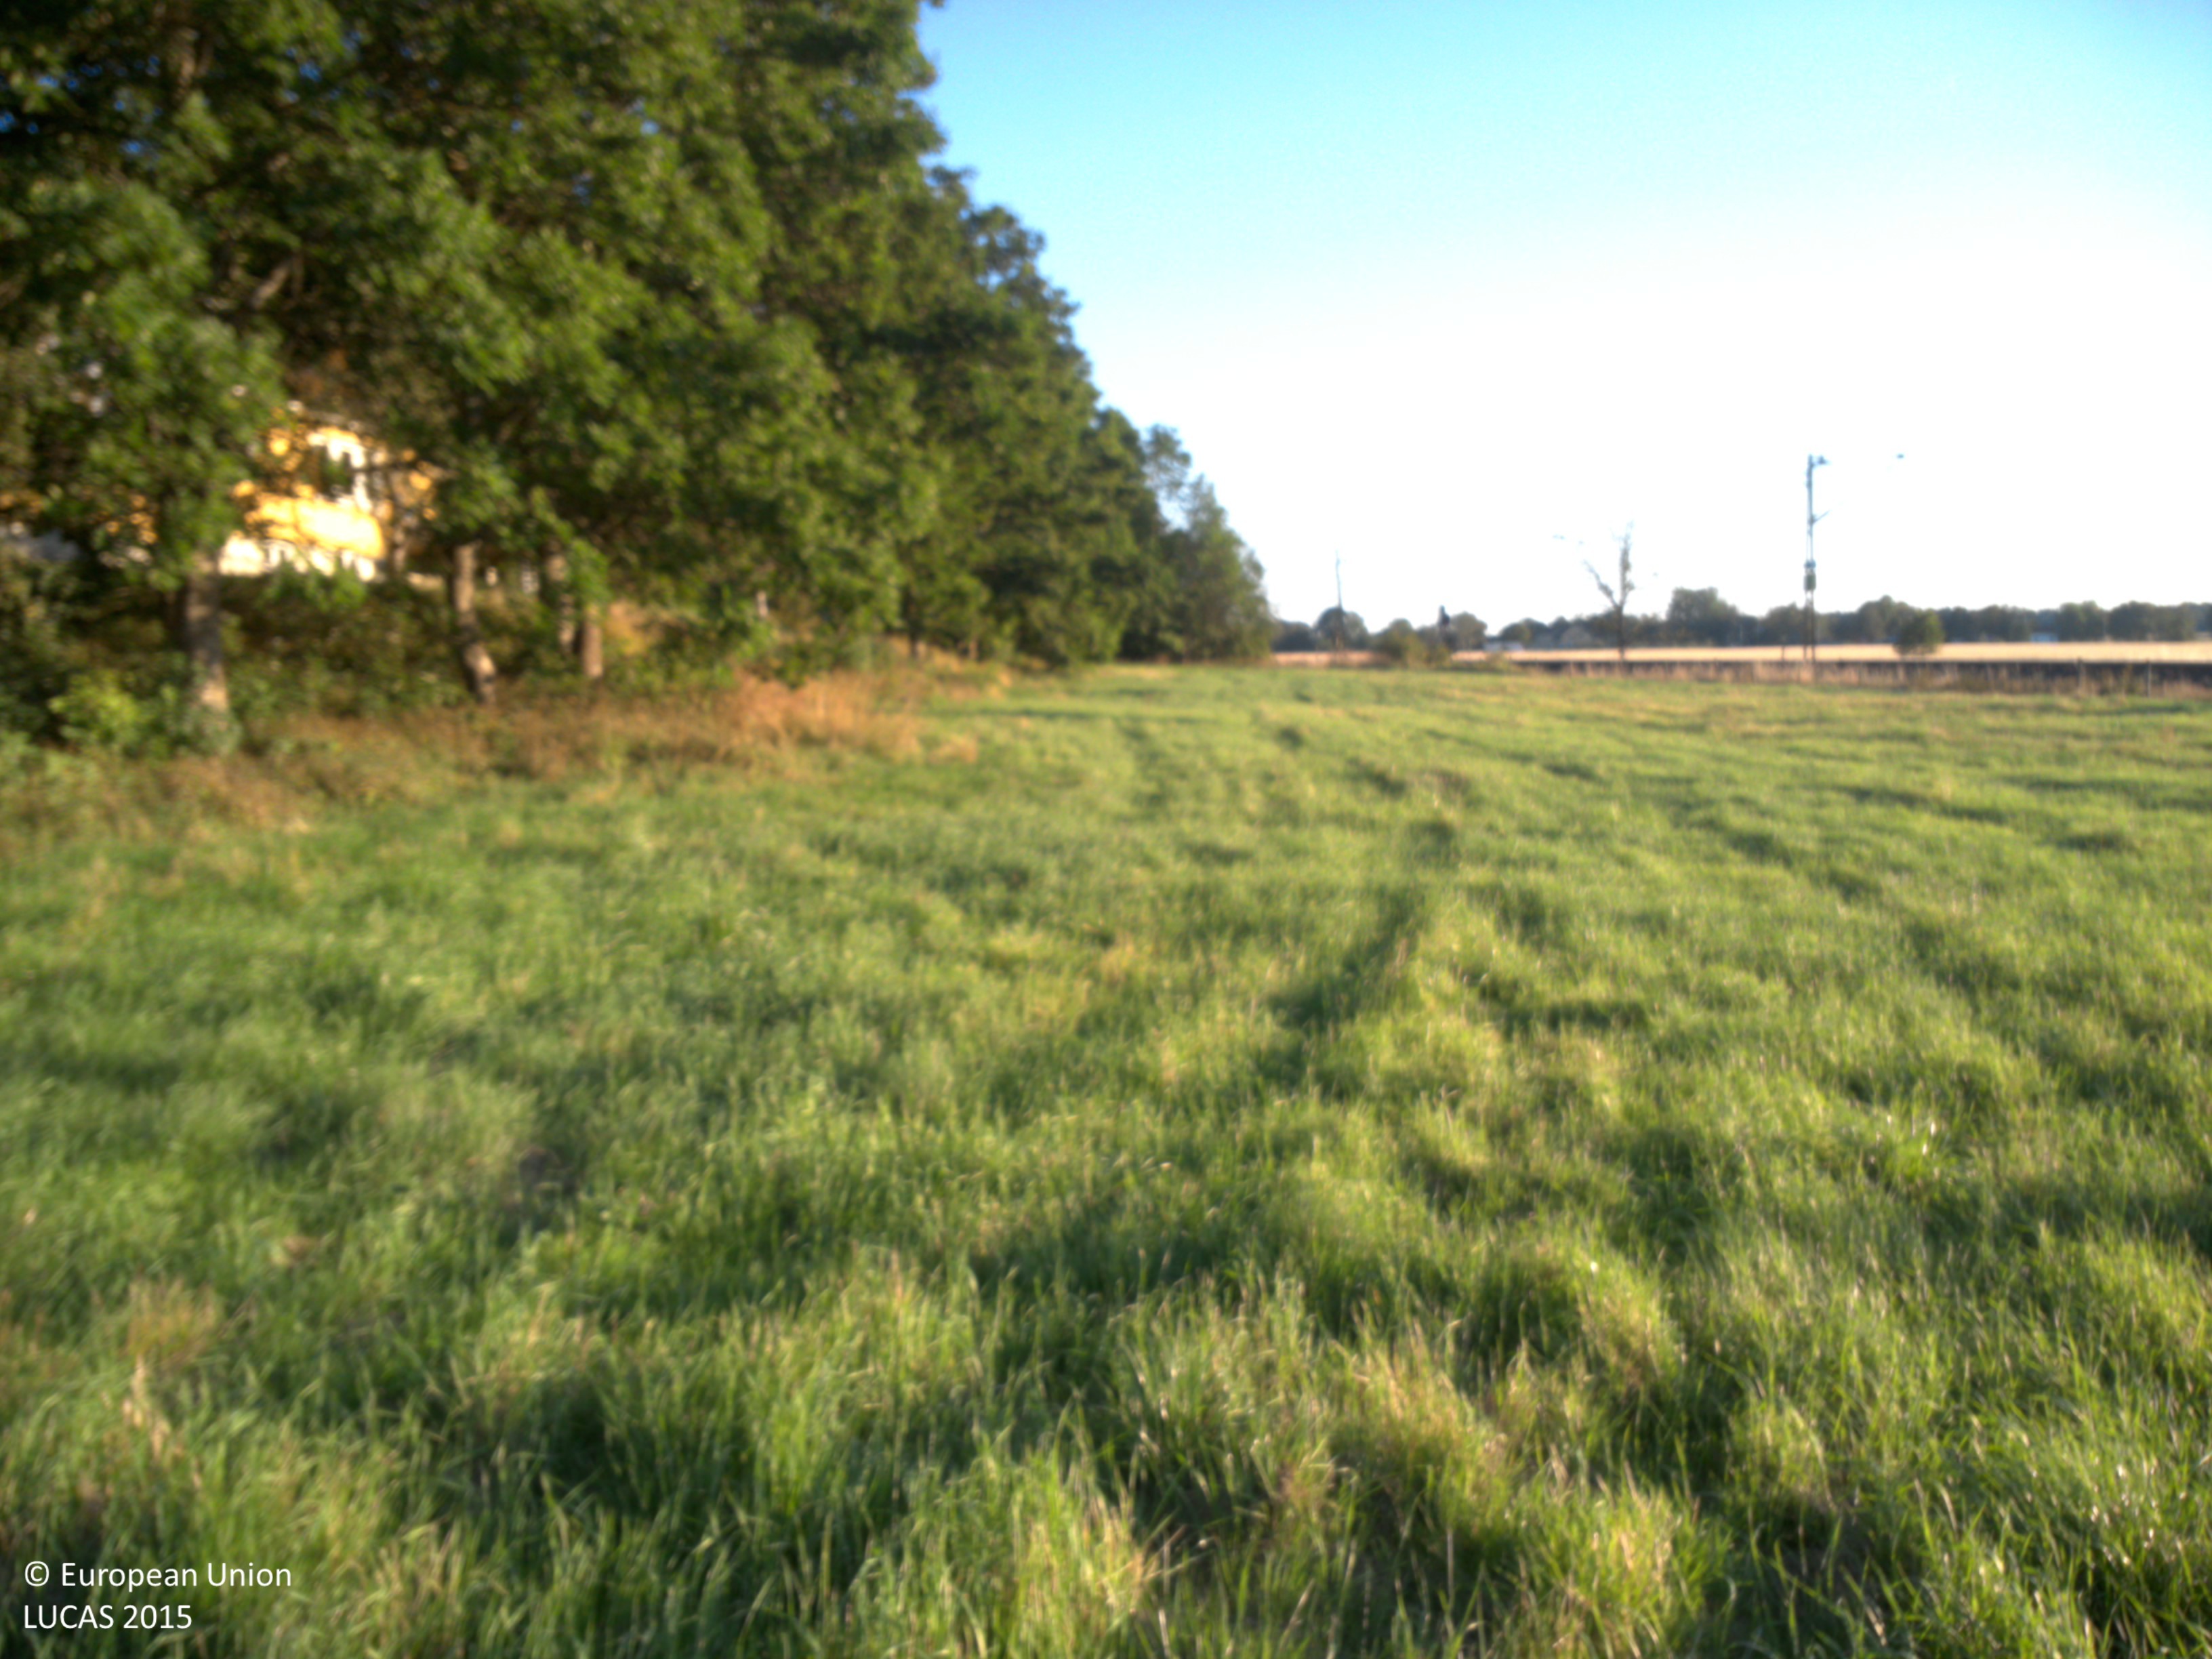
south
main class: Grassland
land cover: Grassland without tree/shrub cover
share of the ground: > 75 %
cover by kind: herbaceous plants 100 %
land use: Agriculture (excluding fallow land and kitchen gardens)
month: August
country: SE
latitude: 58.4881
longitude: 12.2768
